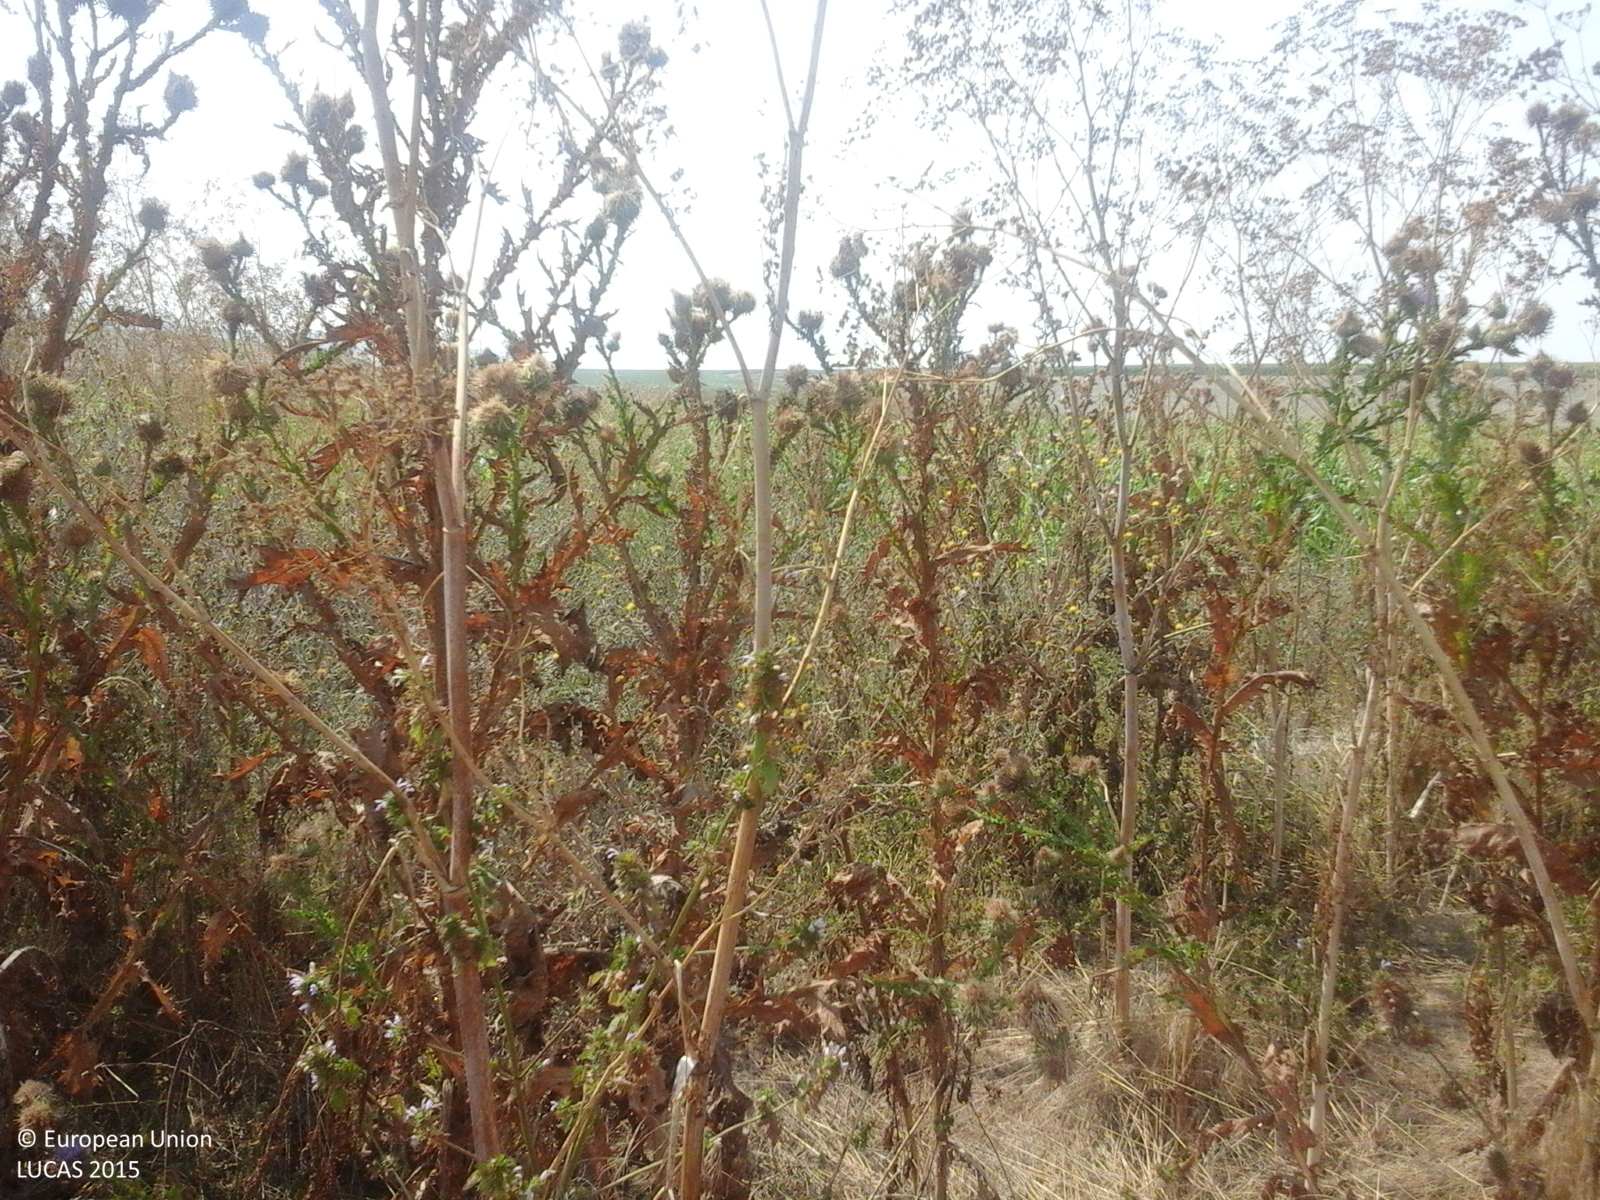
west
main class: Grassland
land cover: Spontaneously vegetated surfaces
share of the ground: > 75 %
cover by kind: herbaceous plants 100 %
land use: Semi-natural and natural areas not in use
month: July
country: RO
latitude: 44.9730
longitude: 28.3183
